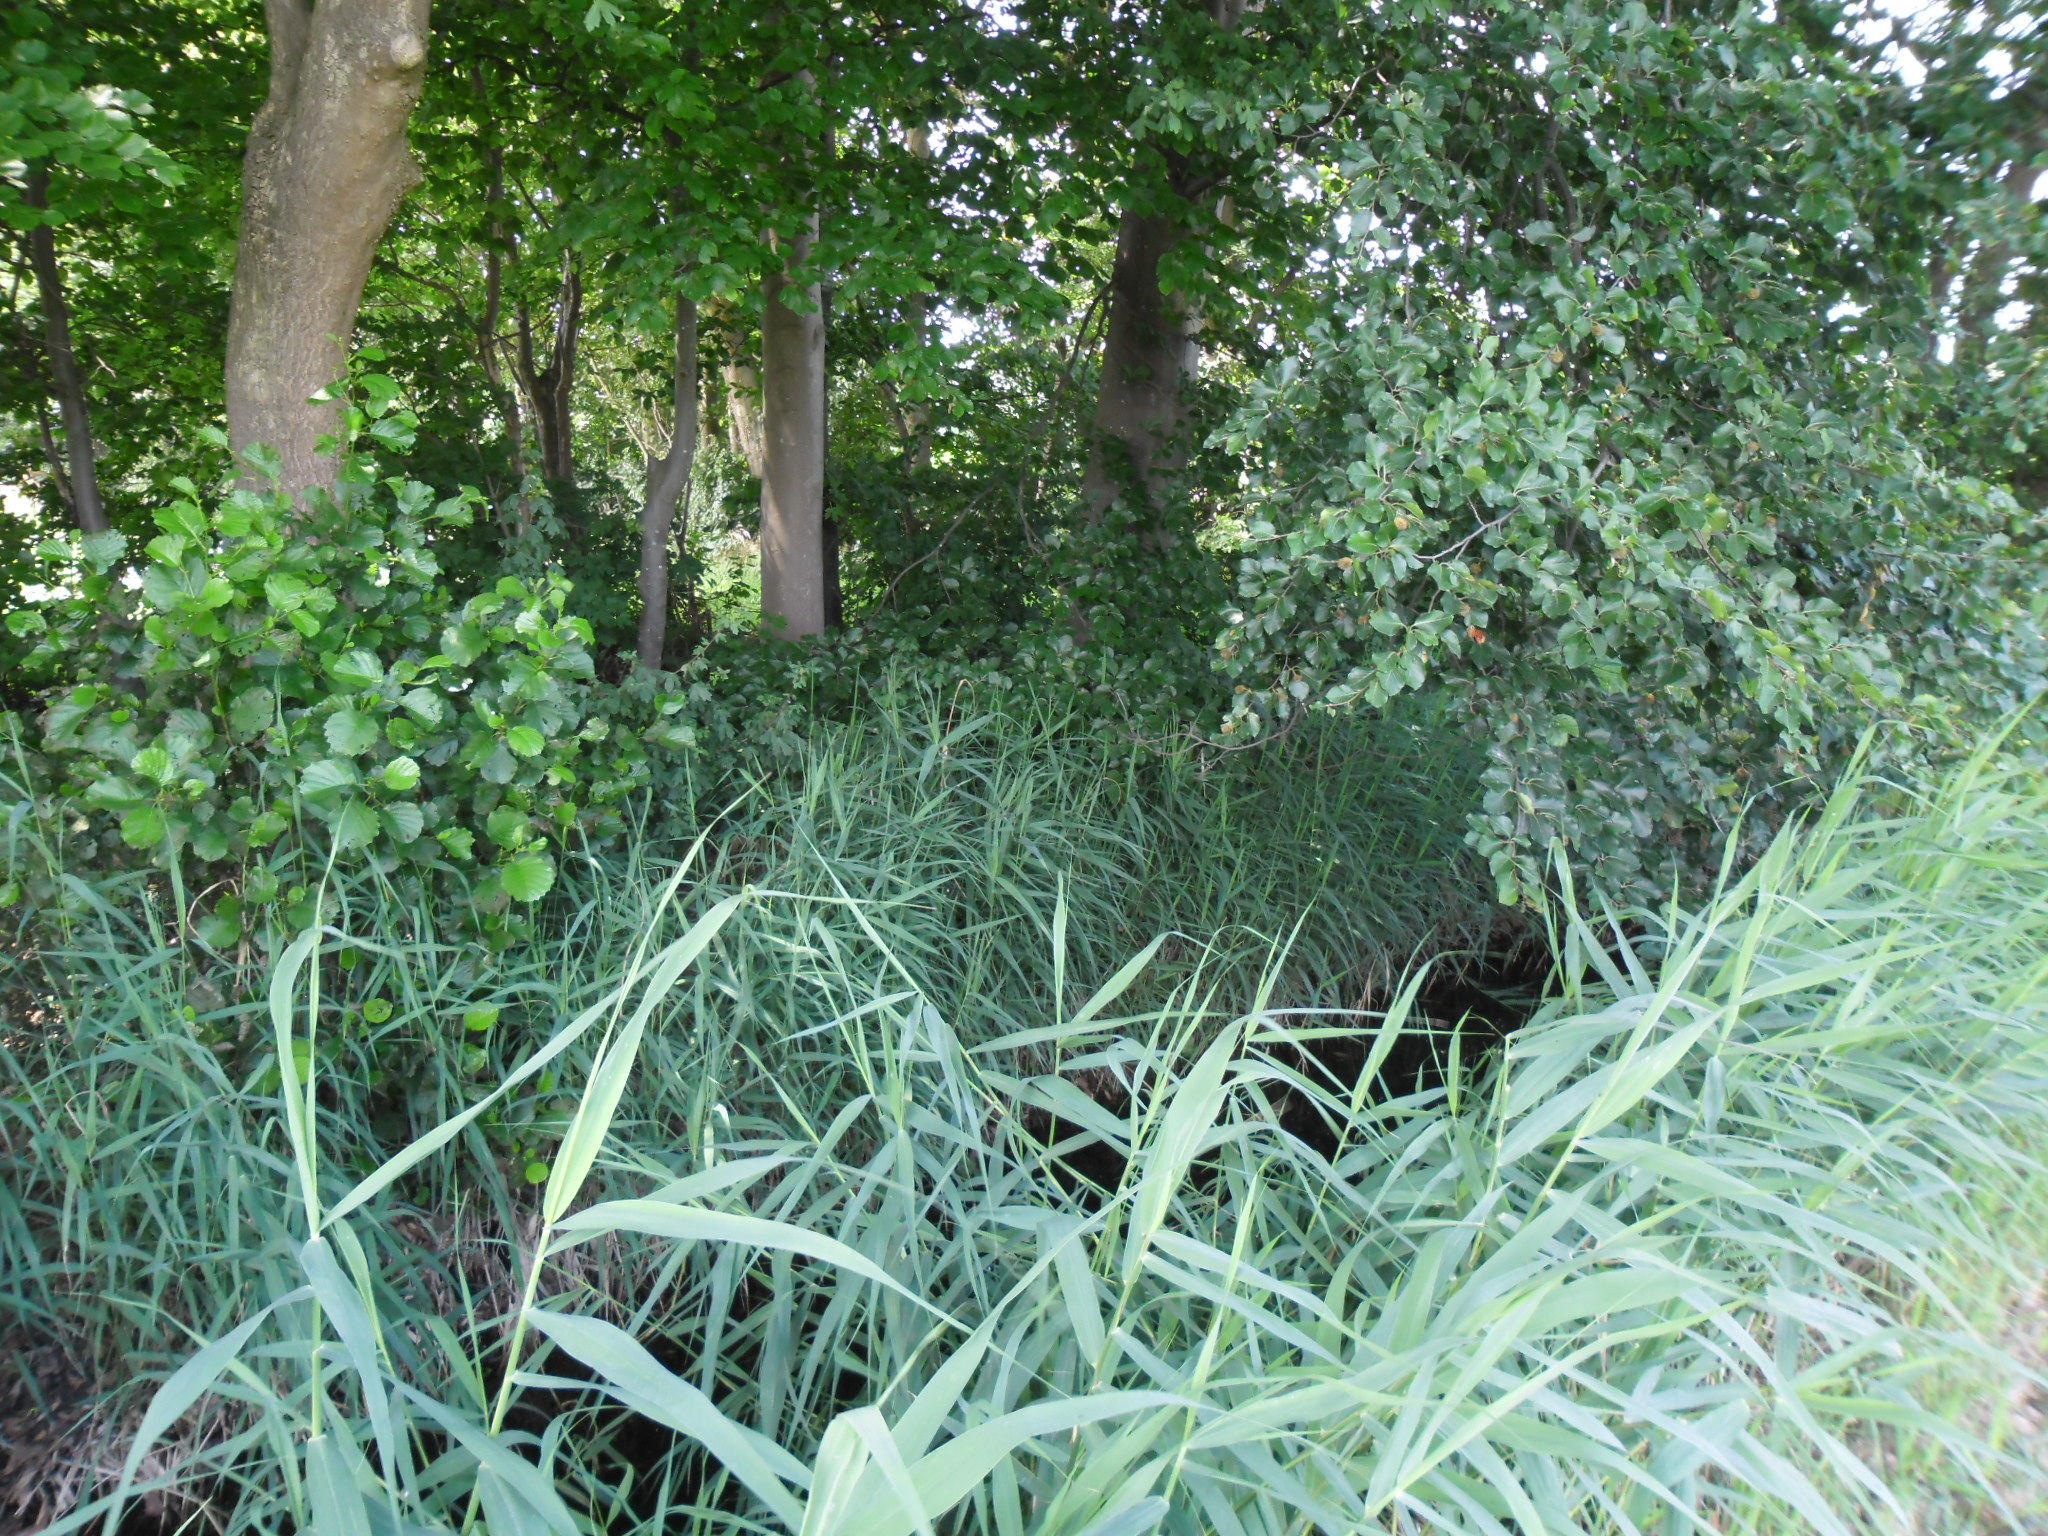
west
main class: Grassland
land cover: Grassland without tree/shrub cover
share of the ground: > 75 %
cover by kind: herbaceous plants 100 %
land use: Agriculture (excluding fallow land and kitchen gardens)
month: July
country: NL
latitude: 52.6753
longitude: 5.6358
